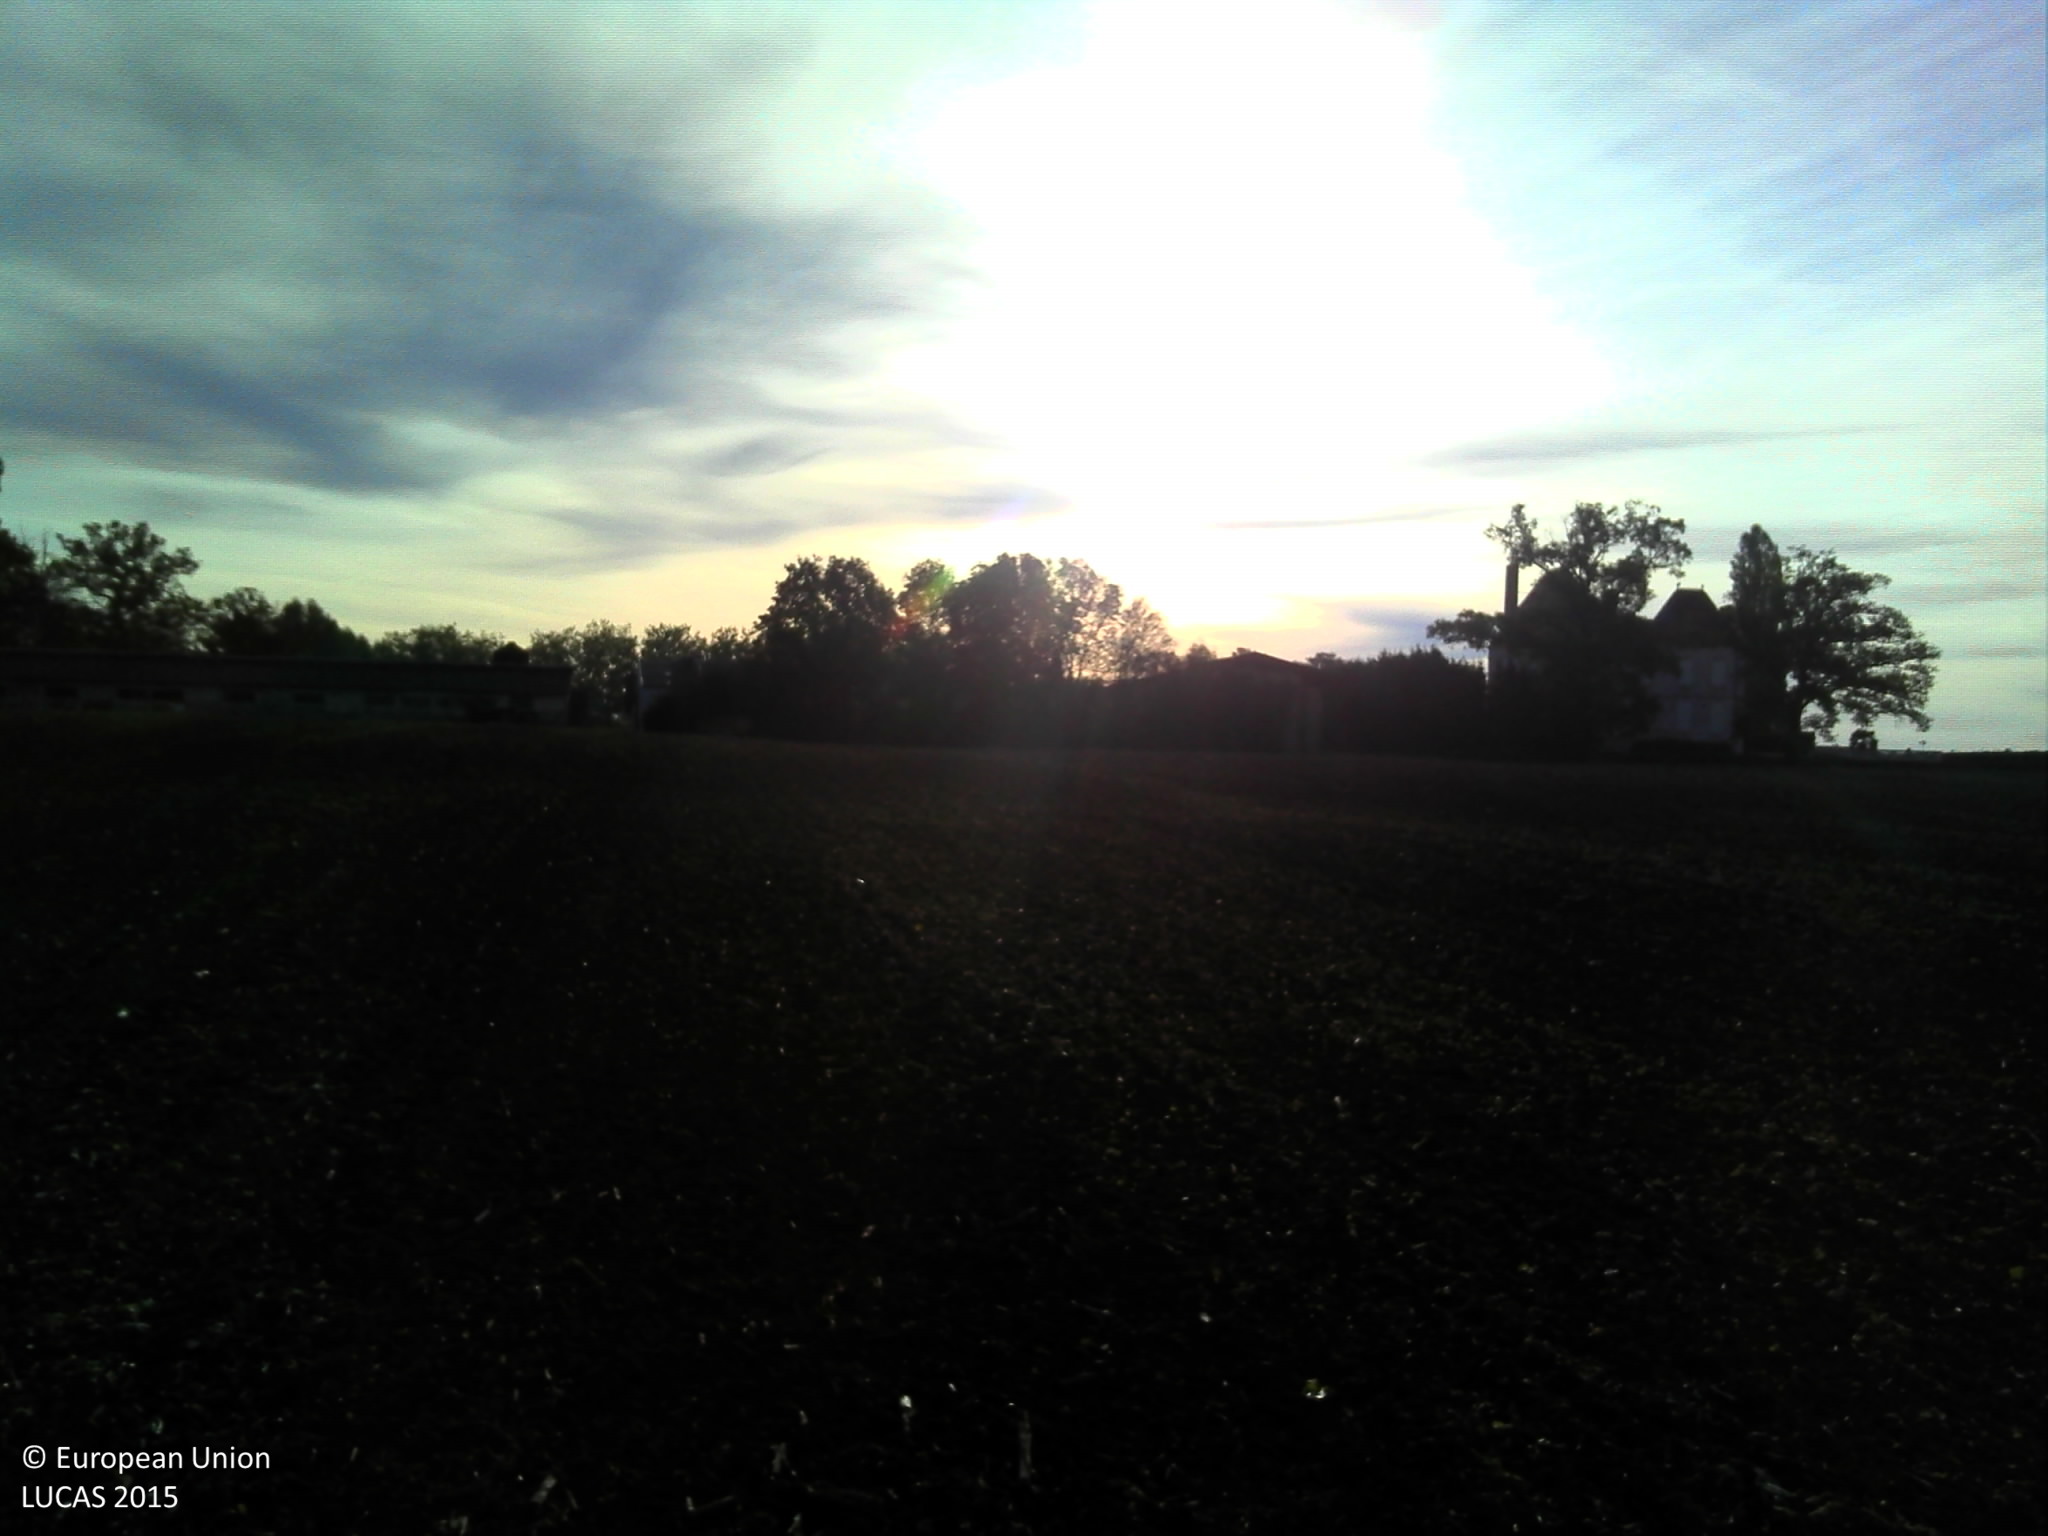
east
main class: Cropland
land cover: Sunflower
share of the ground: > 75 %
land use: Agriculture (excluding fallow land and kitchen gardens)
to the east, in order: Sunflower; Artificial constructions in urban areas; Grassland without tree/shrub cover
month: October
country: FR
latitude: 46.3989
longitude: 5.0470
